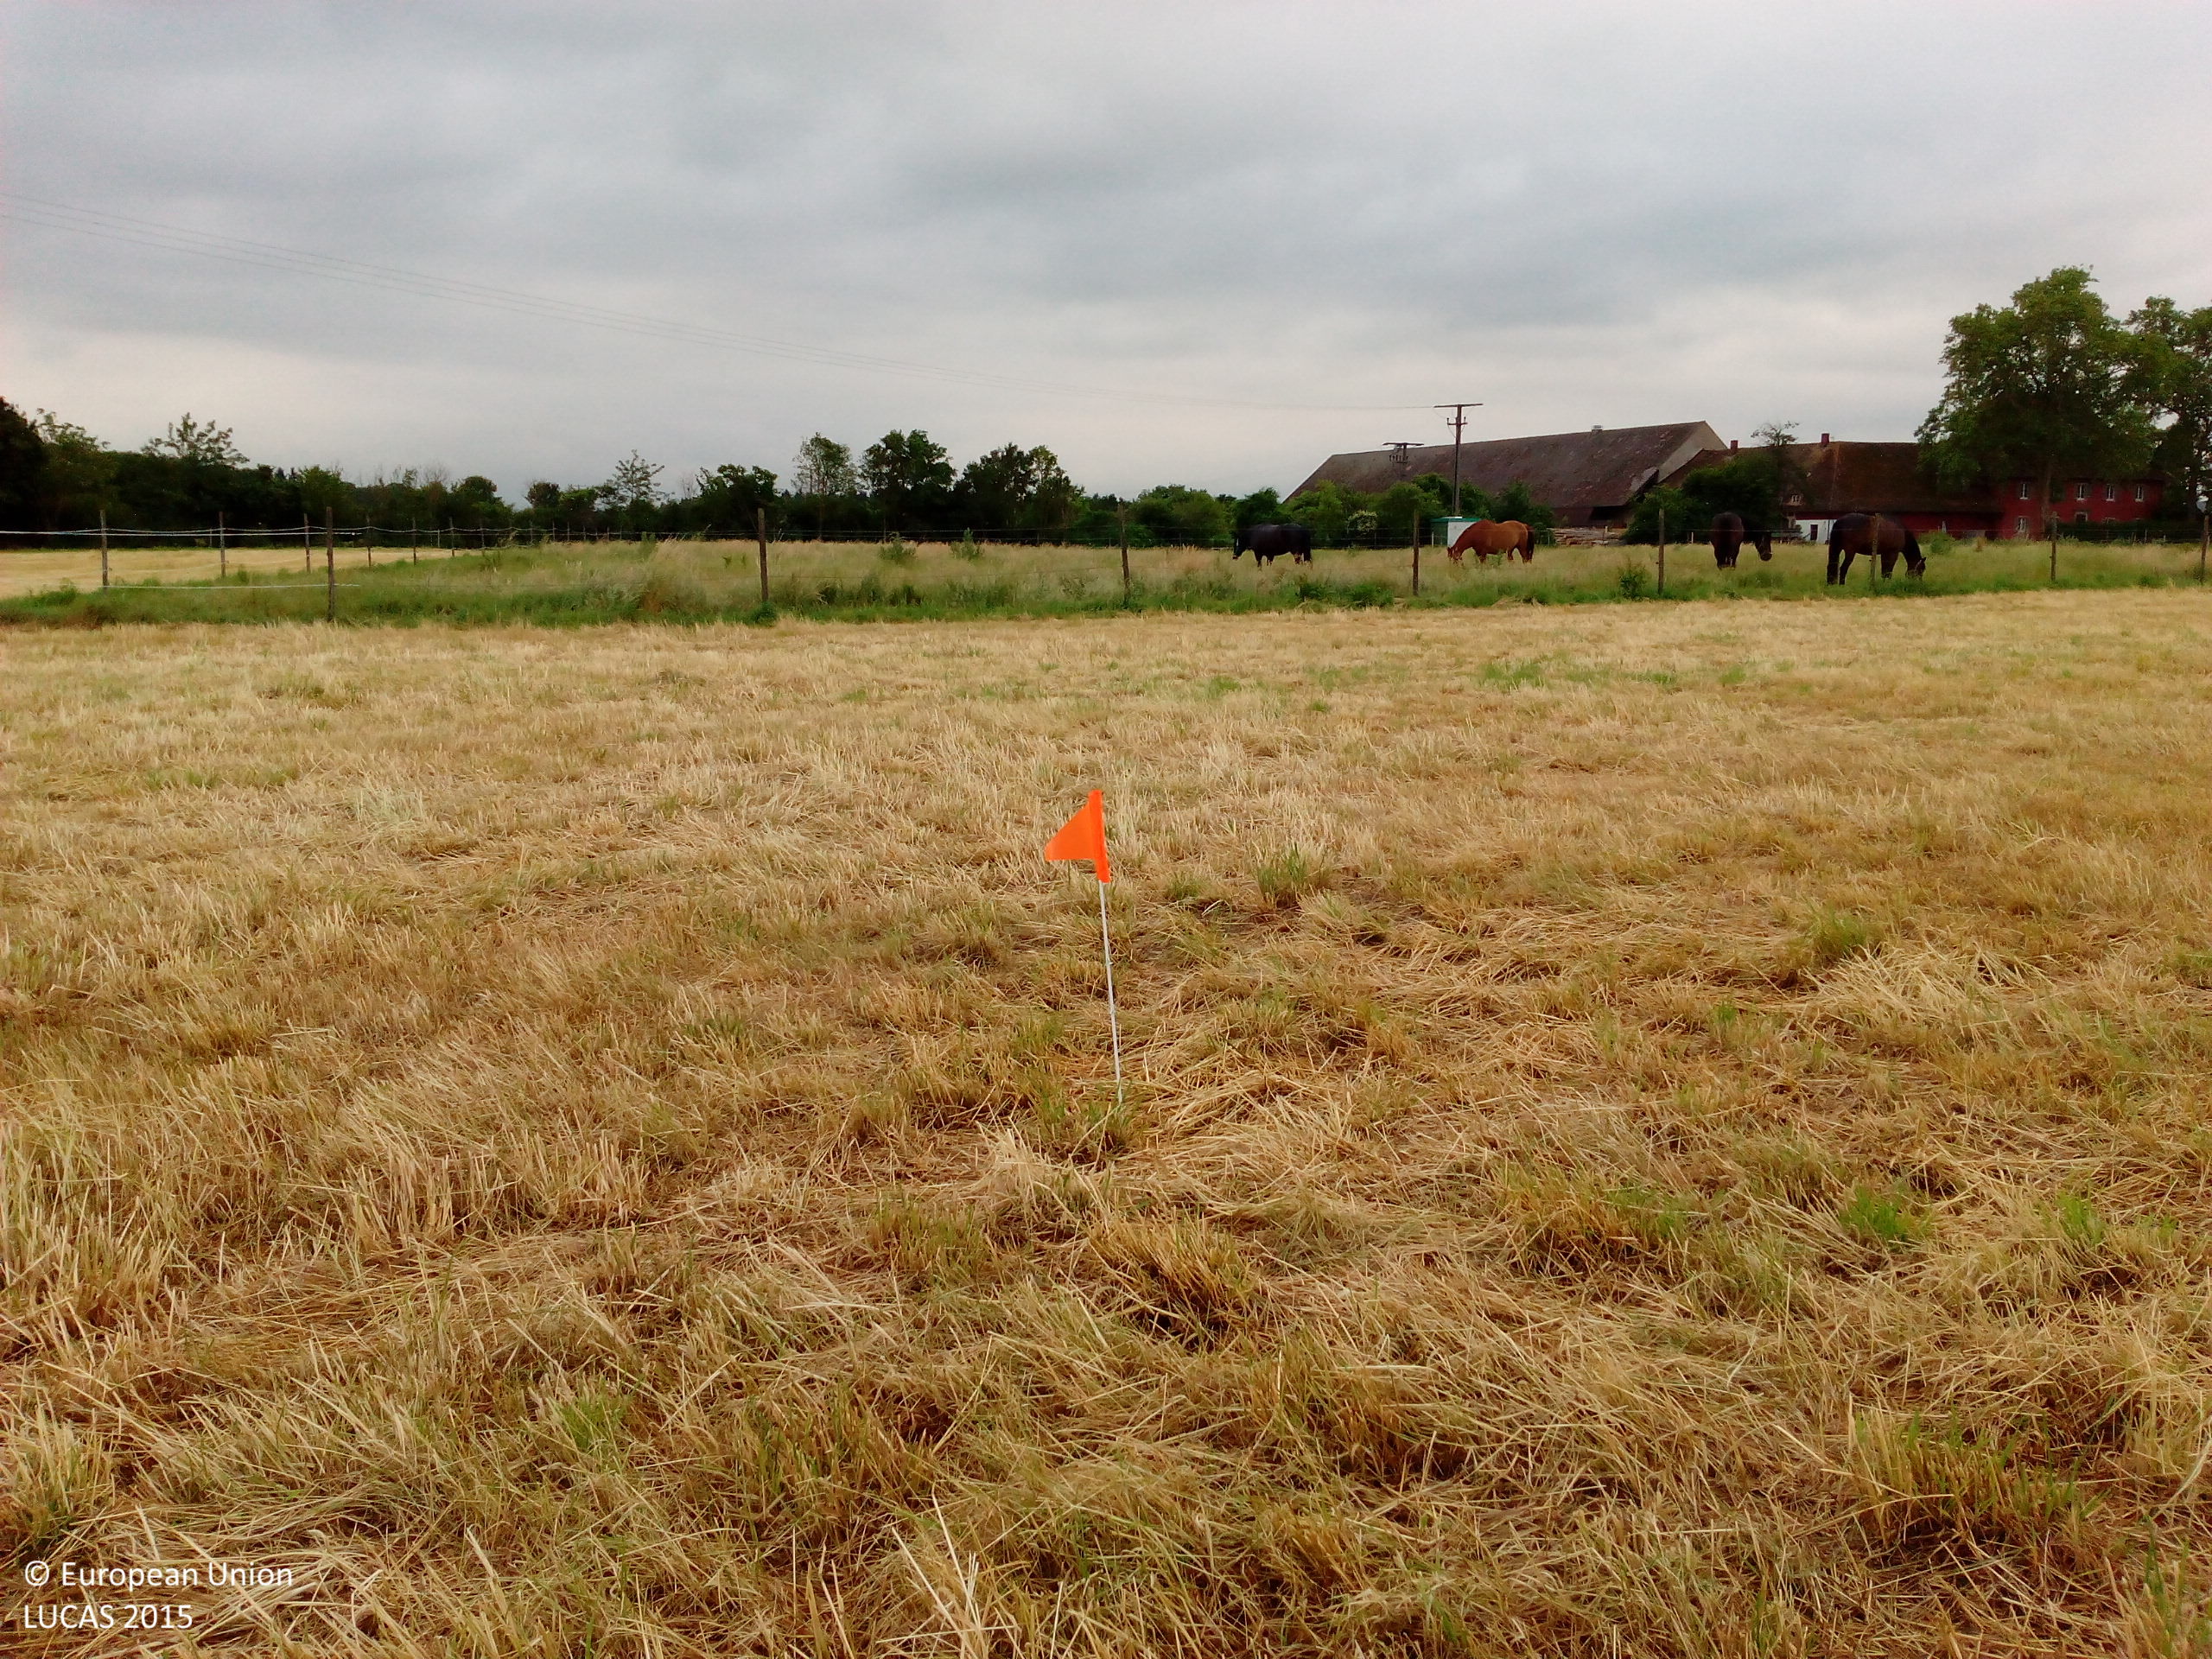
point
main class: Grassland
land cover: Grassland without tree/shrub cover
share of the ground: > 75 %
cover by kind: herbaceous plants 100 %
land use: Agriculture (excluding fallow land and kitchen gardens)
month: June
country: DE
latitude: 48.0000
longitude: 7.6289
